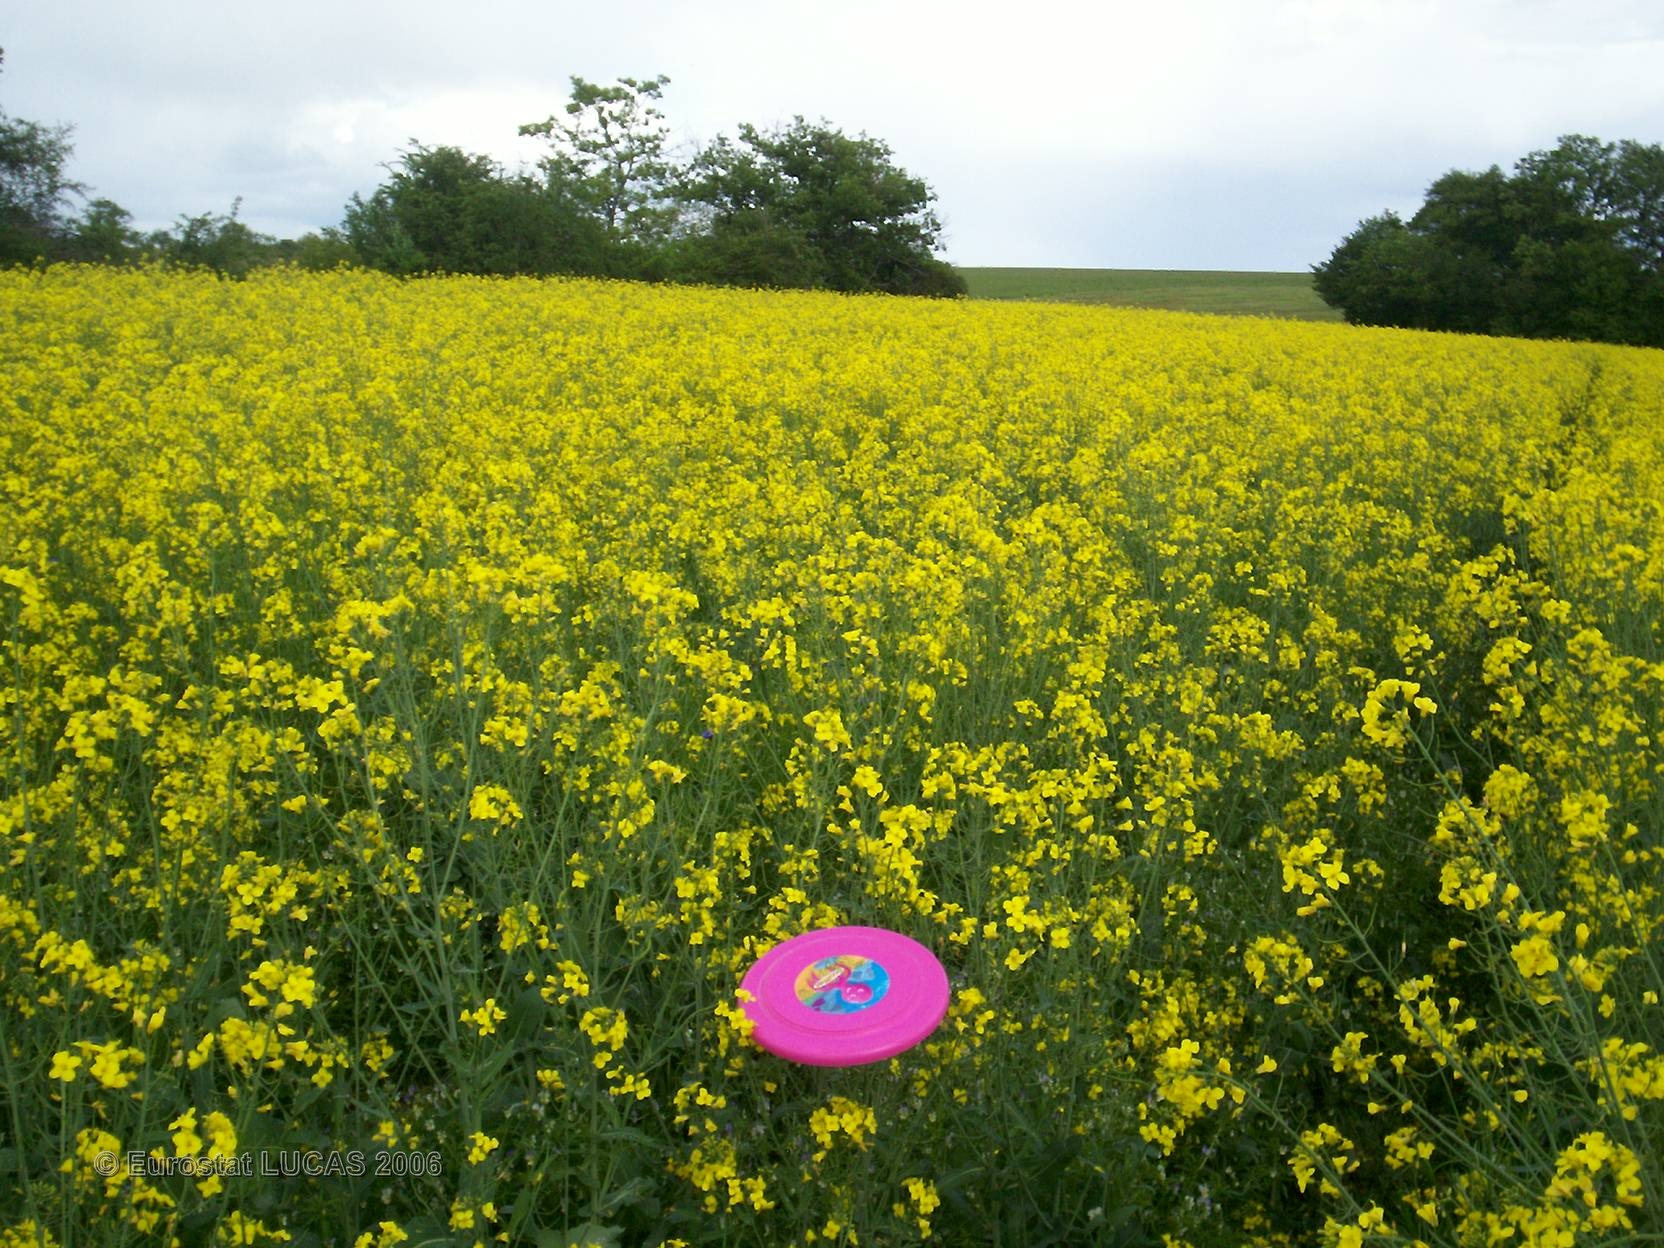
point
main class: Cropland
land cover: Rape and turnip rape
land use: Agriculture (excluding fallow land and kitchen gardens)
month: May
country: FR
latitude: 46.9933
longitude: 4.6486
